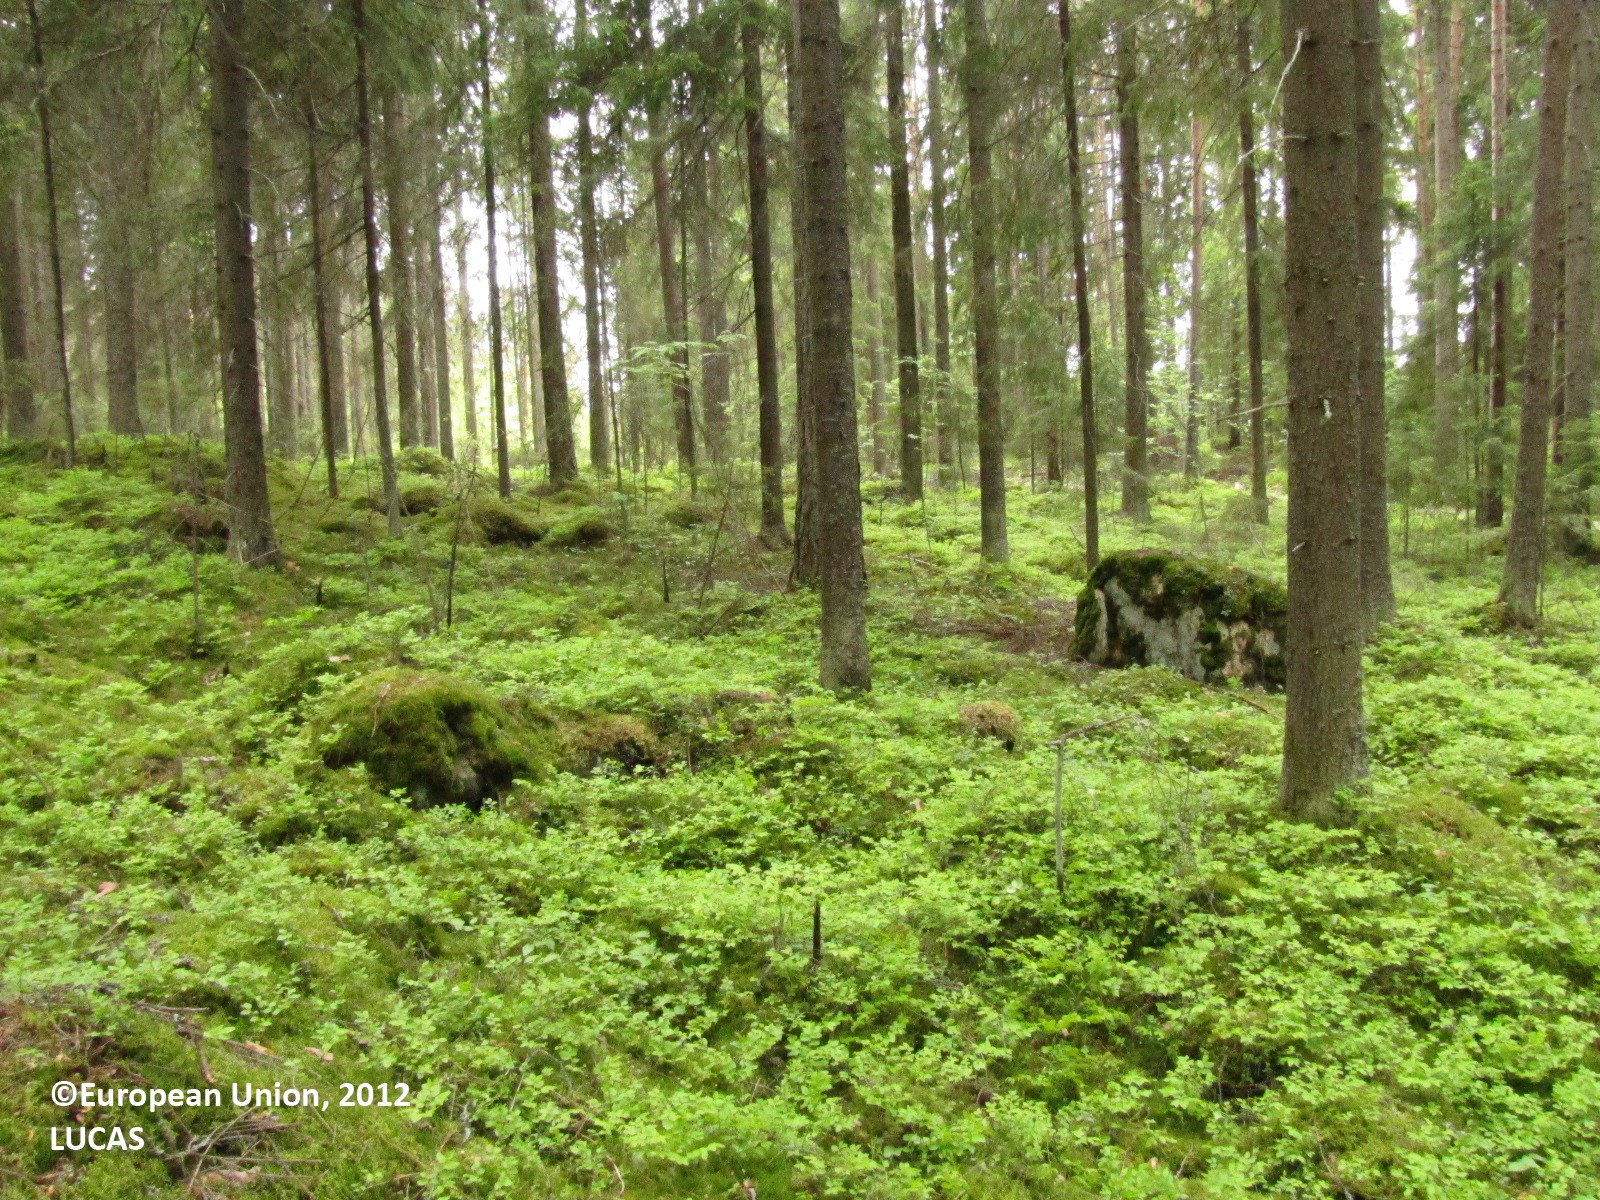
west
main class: Woodland
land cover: Spruce dominated coniferous woodland
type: hemiboreal forest and nemoral coniferous forest and mixed broadleaved-coniferous forest
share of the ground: > 75 %
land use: Forestry
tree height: > 5 m
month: June
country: FI
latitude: 61.6155
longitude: 23.1017
